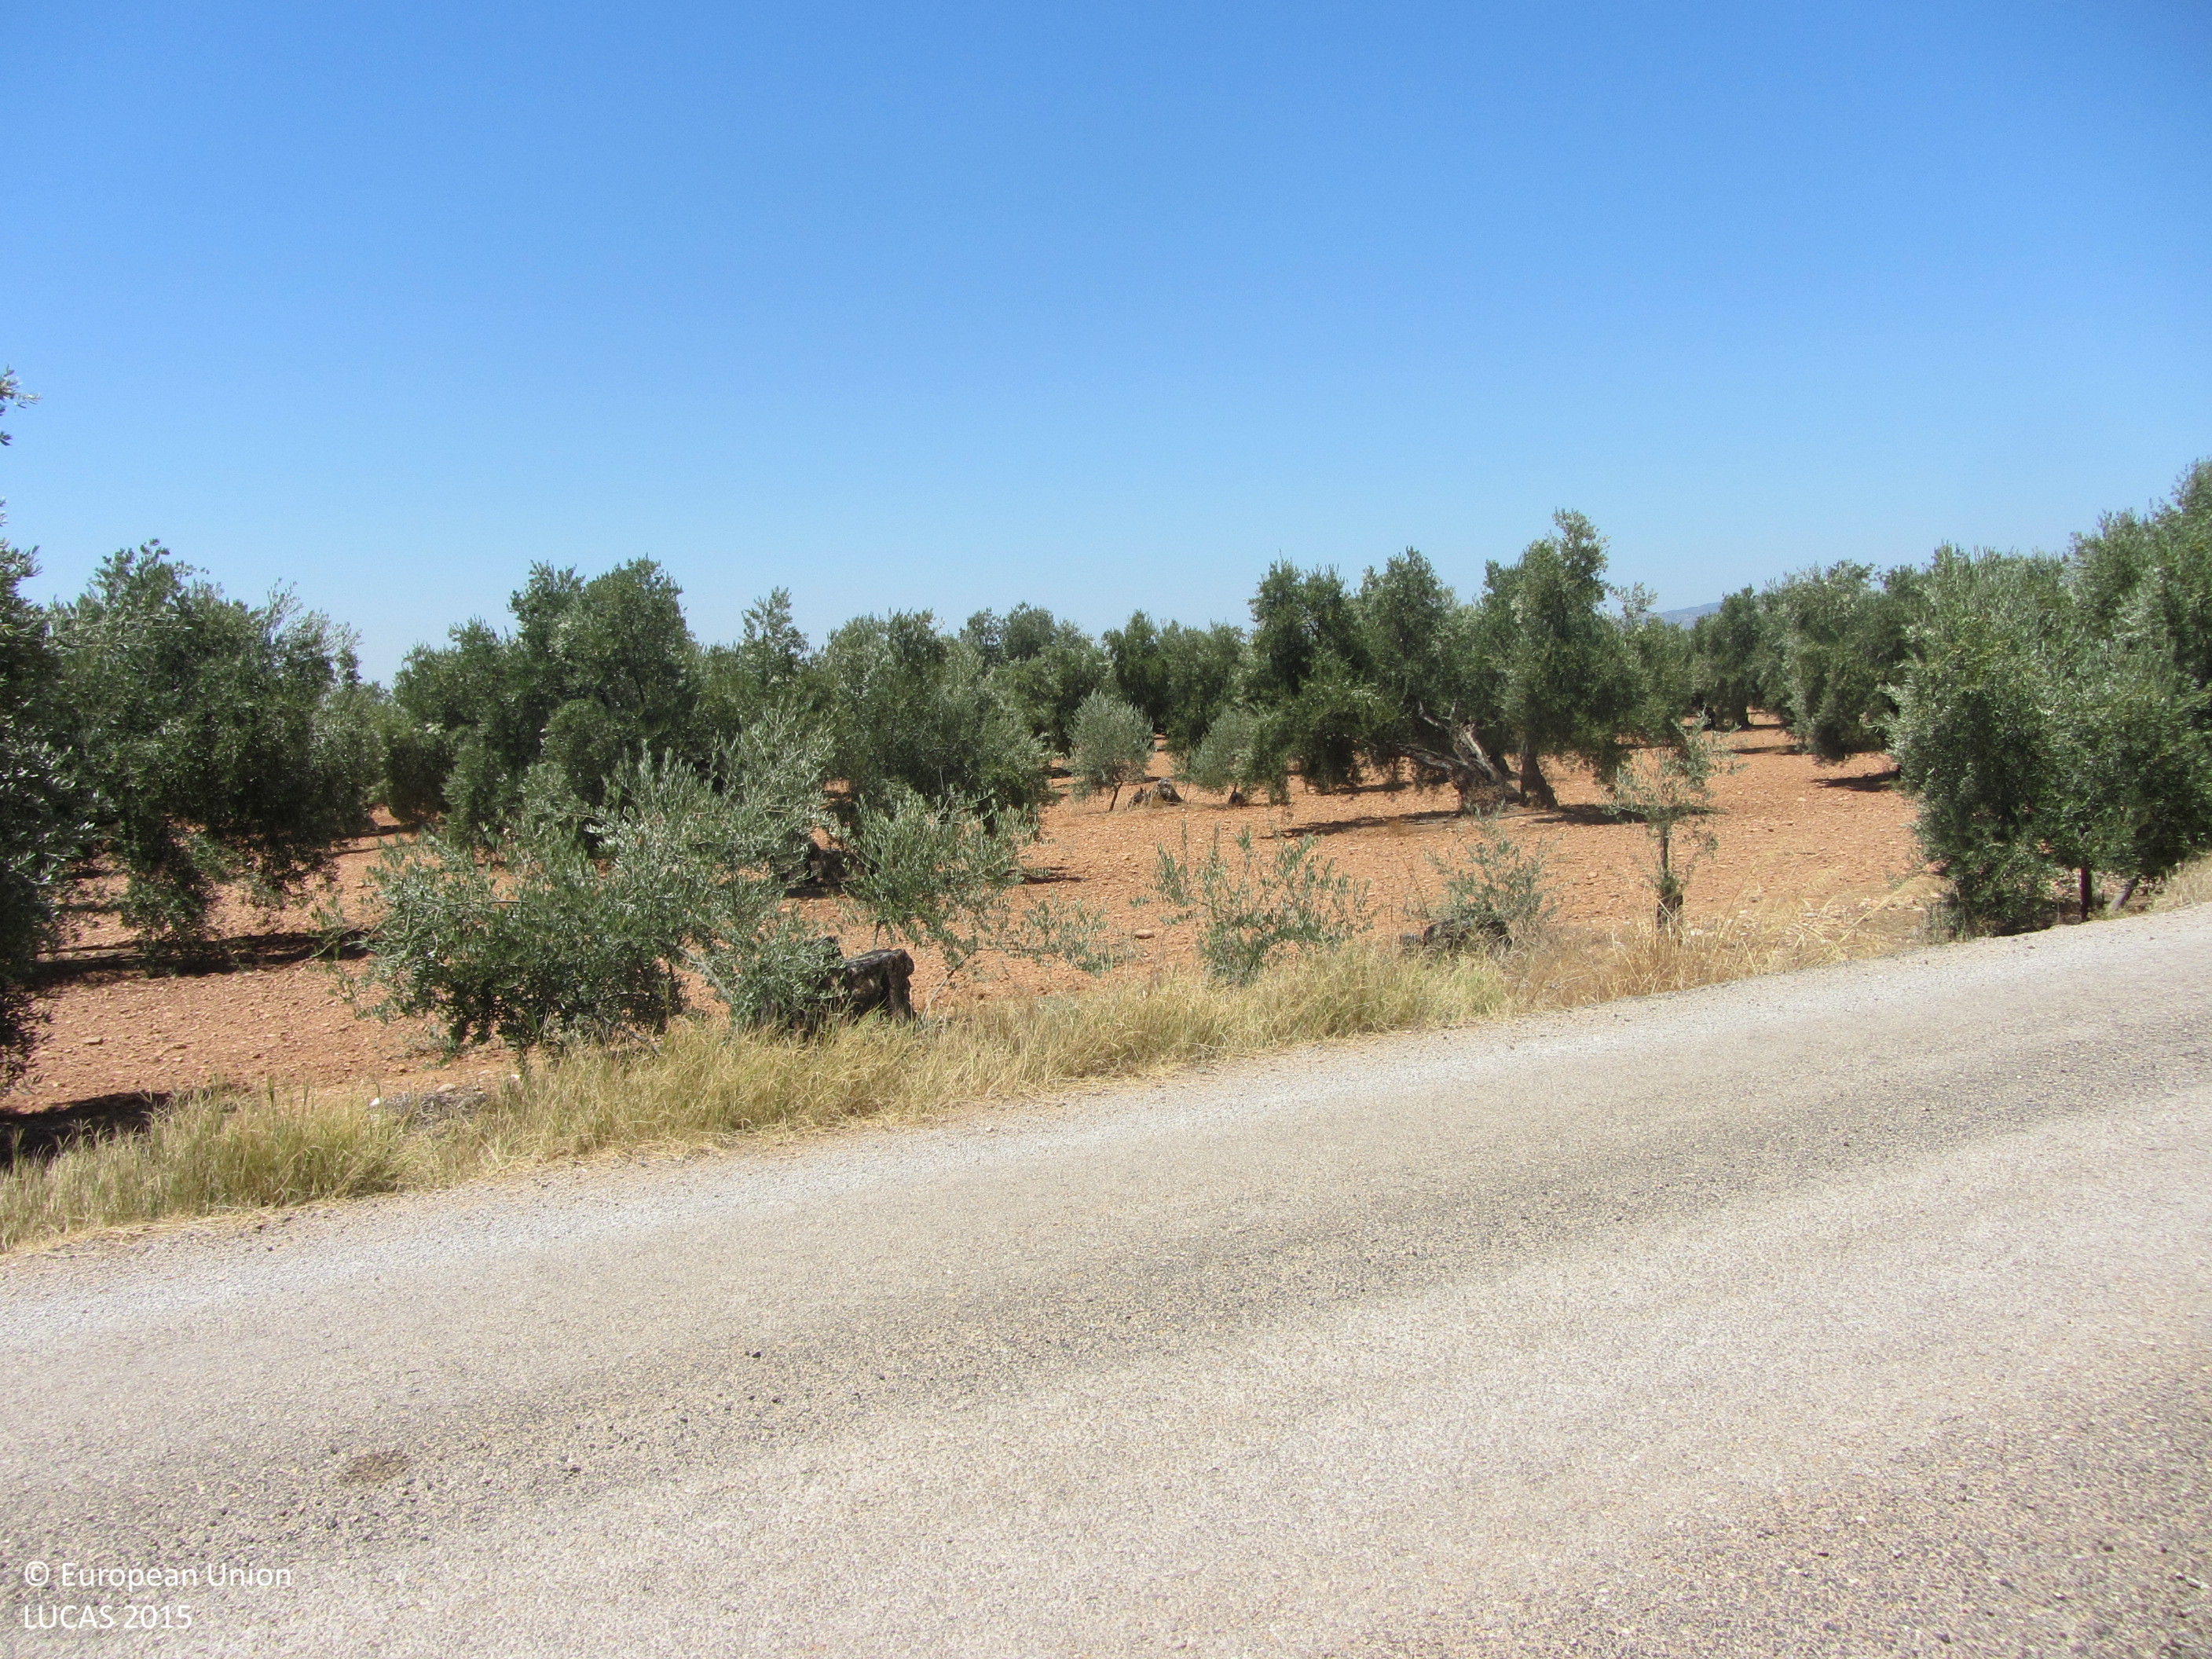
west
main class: Cropland
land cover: Olive groves
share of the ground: 25 - 50 %
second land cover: Other bare soil
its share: > 75 %
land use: Agriculture (excluding fallow land and kitchen gardens)
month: July
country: ES
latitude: 38.0296
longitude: -3.8702
